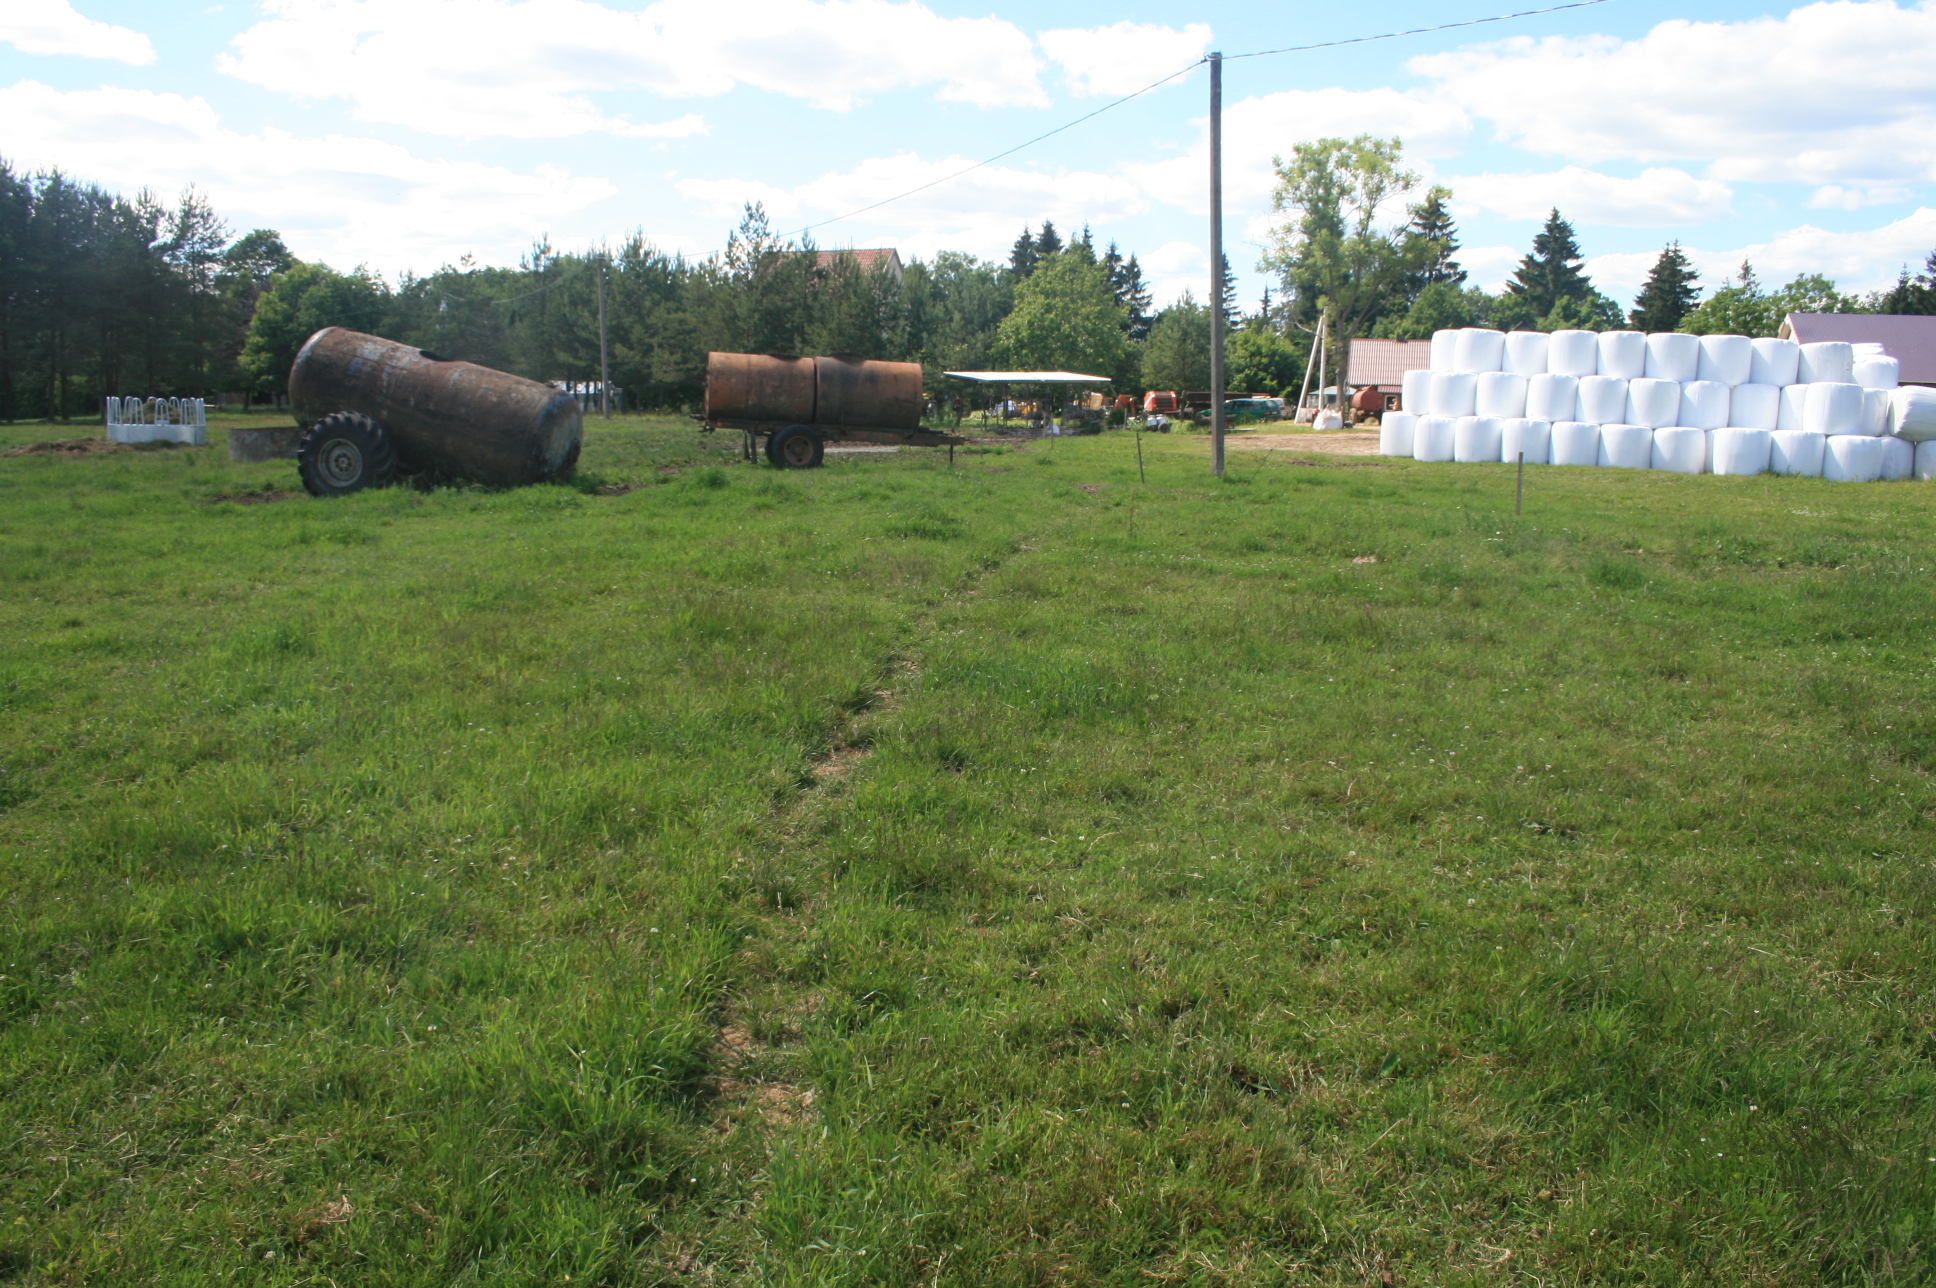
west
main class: Grassland
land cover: Grassland without tree/shrub cover
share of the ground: > 75 %
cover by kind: herbaceous plants 100 %
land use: Agriculture (excluding fallow land and kitchen gardens)
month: June
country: LT
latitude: 55.4177
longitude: 22.0445
